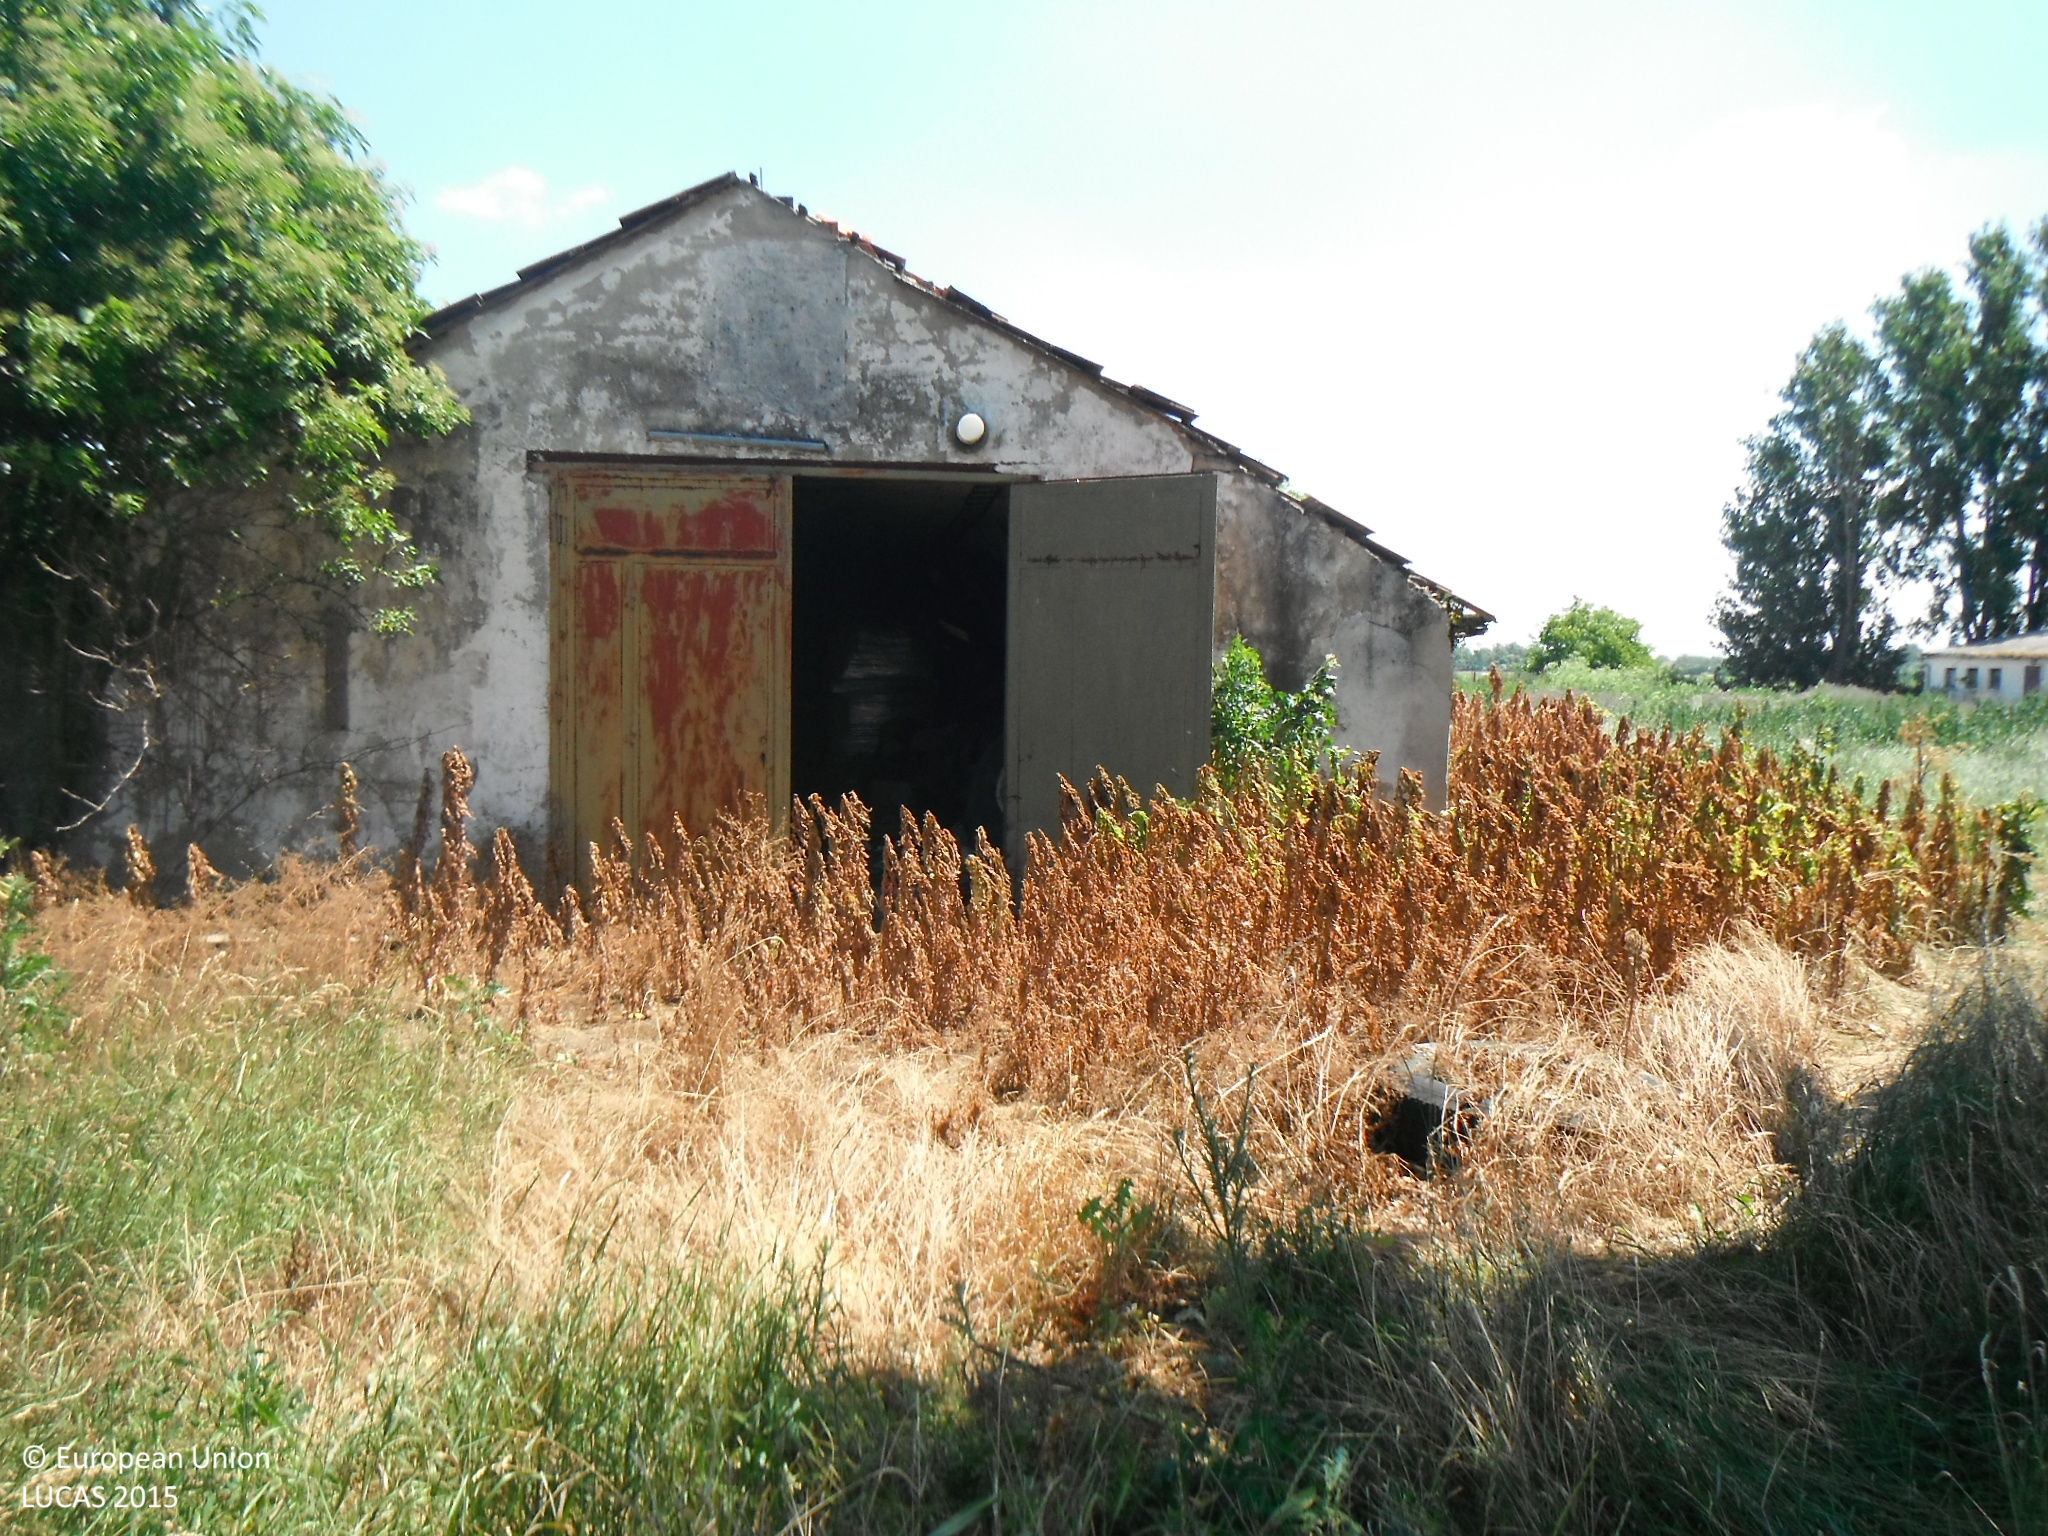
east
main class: Grassland
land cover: Spontaneously vegetated surfaces
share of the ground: > 75 %
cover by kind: herbaceous plants 100 %
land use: Abandoned areas
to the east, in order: Spontaneously vegetated surfaces; Artificial constructions in urban areas; Shruby margins; Tracks; Grassland without tree/shrub cover; Shruby margins; Ditches and canals; Spontaneously vegetated surfaces; Maize
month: June
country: SK
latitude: 47.8470
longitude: 18.1778
